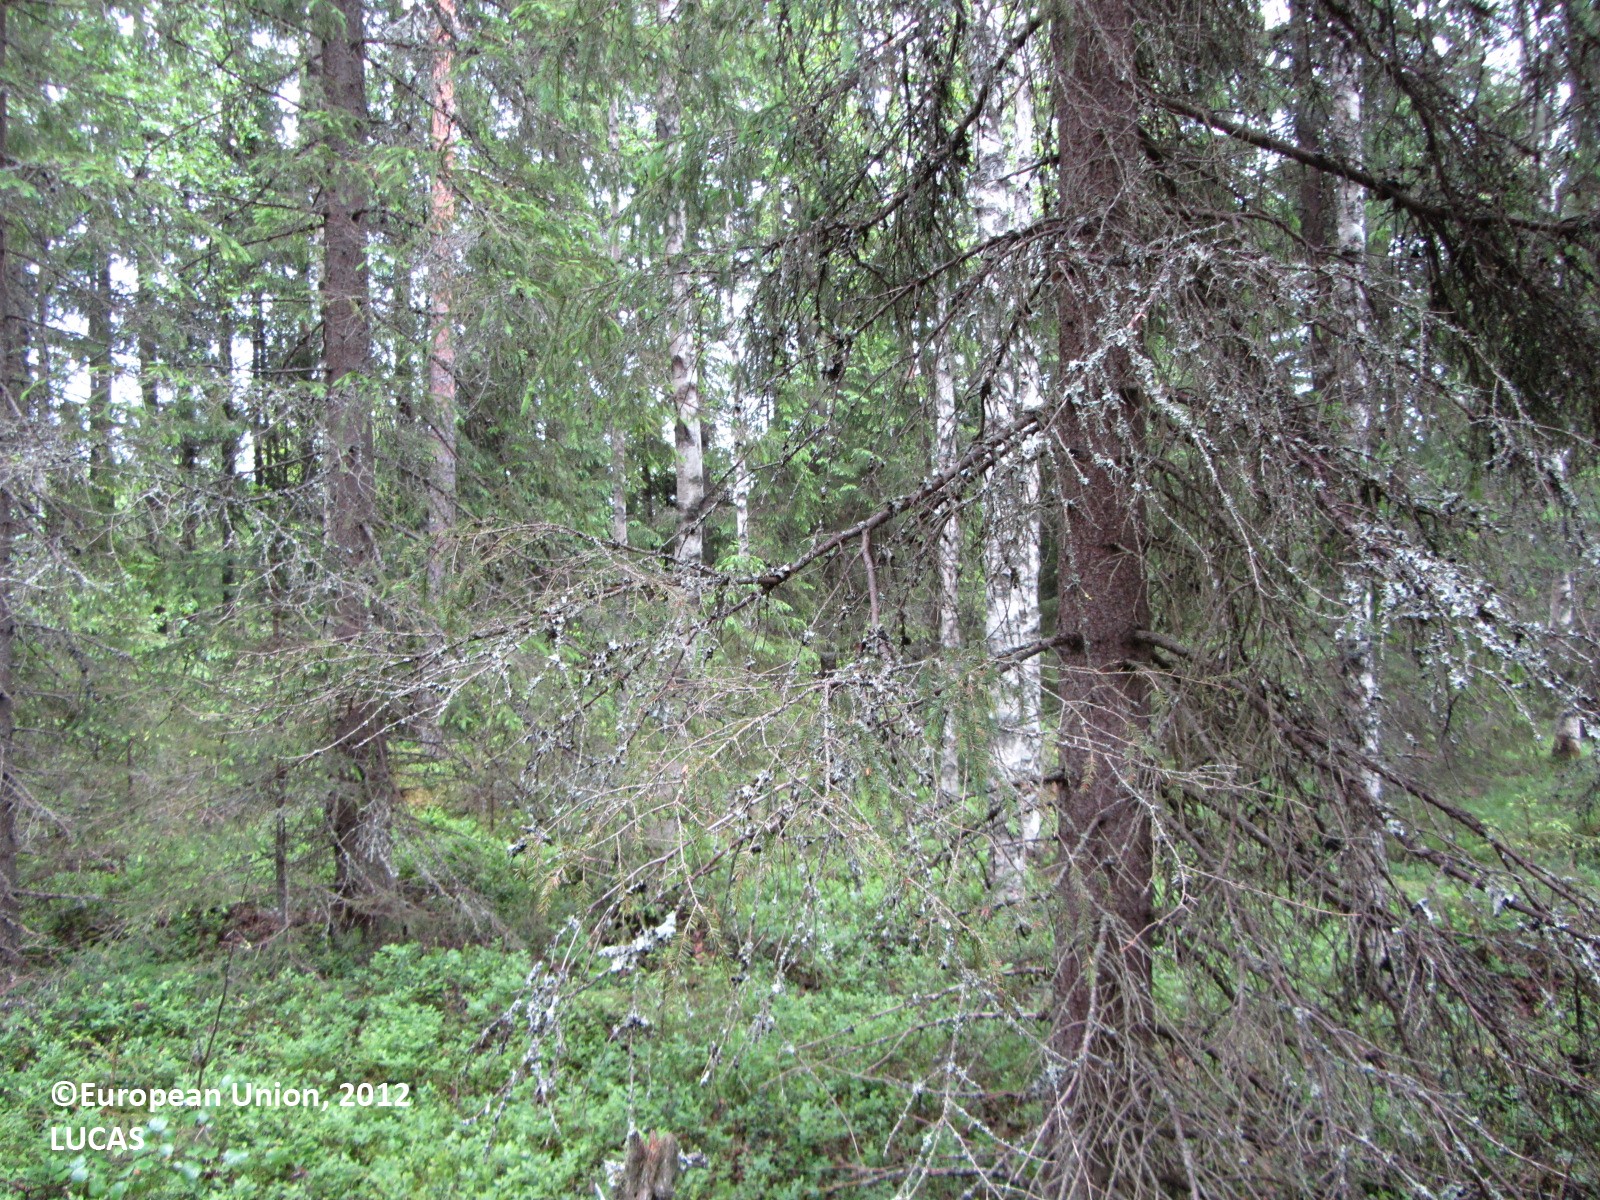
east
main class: Woodland
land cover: Spruce dominated mixed woodland
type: boreal forest
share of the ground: 50 - 75 %
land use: Forestry
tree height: > 5 m
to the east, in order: Spruce dominated mixed woodland; Other mixed woodland; Ditches and canals; Spruce dominated coniferous woodland; Tracks; Spruce dominated mixed woodland; Tracks; Spruce dominated mixed woodland; Ditches and canals; Spruce dominated mixed woodland; Tracks; Spruce dominated mixed woodland; Pine dominated mixed woodland; Tracks; Pine dominated mixed woodland; Tracks; Pine dominated coniferous woodland; Tracks; Pine dominated coniferous woodland; Tracks; Pine dominated coniferous woodland; Tracks; Pine dominated coniferous woodland; Tracks; Other coniferous woodland; Tracks; Other coniferous woodland; Tracks; Other coniferous woodland; Tracks; Other coniferous woodland; Tracks; Pine dominated mixed woodland
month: June
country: FI
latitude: 62.4691
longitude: 24.9344
